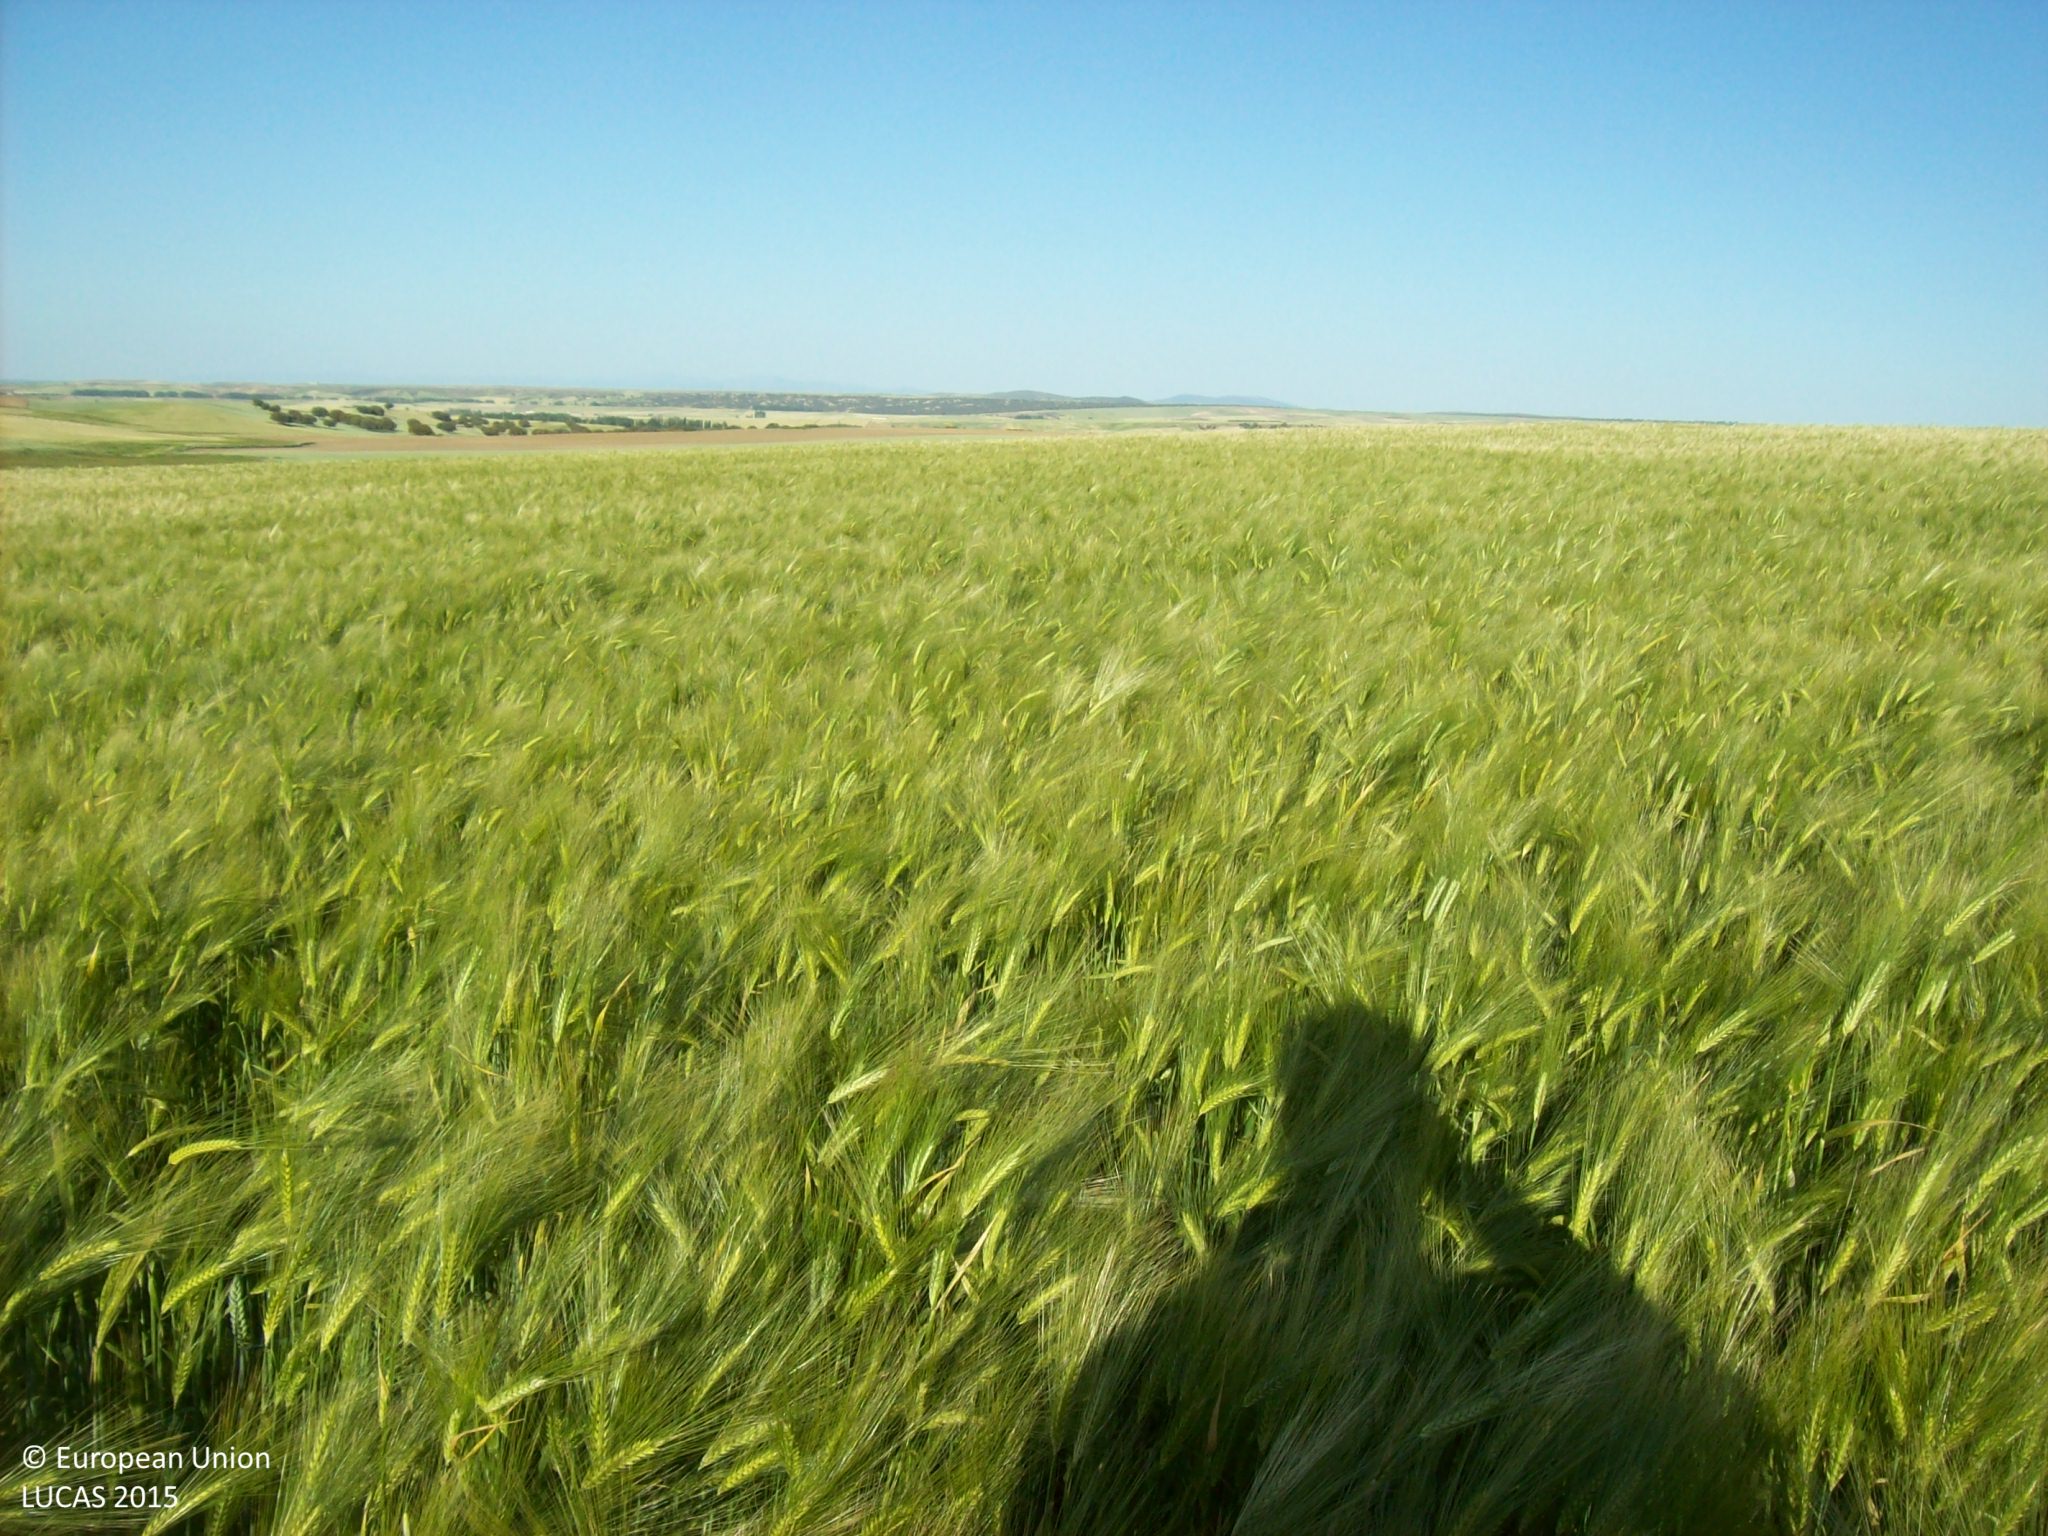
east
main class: Cropland
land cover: Barley
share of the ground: > 75 %
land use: Agriculture (excluding fallow land and kitchen gardens)
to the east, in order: Barley; Grass margins; Tracks; Grass margins; Other fresh vegetables; Common wheat
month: May
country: ES
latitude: 40.7664
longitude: -4.9527
